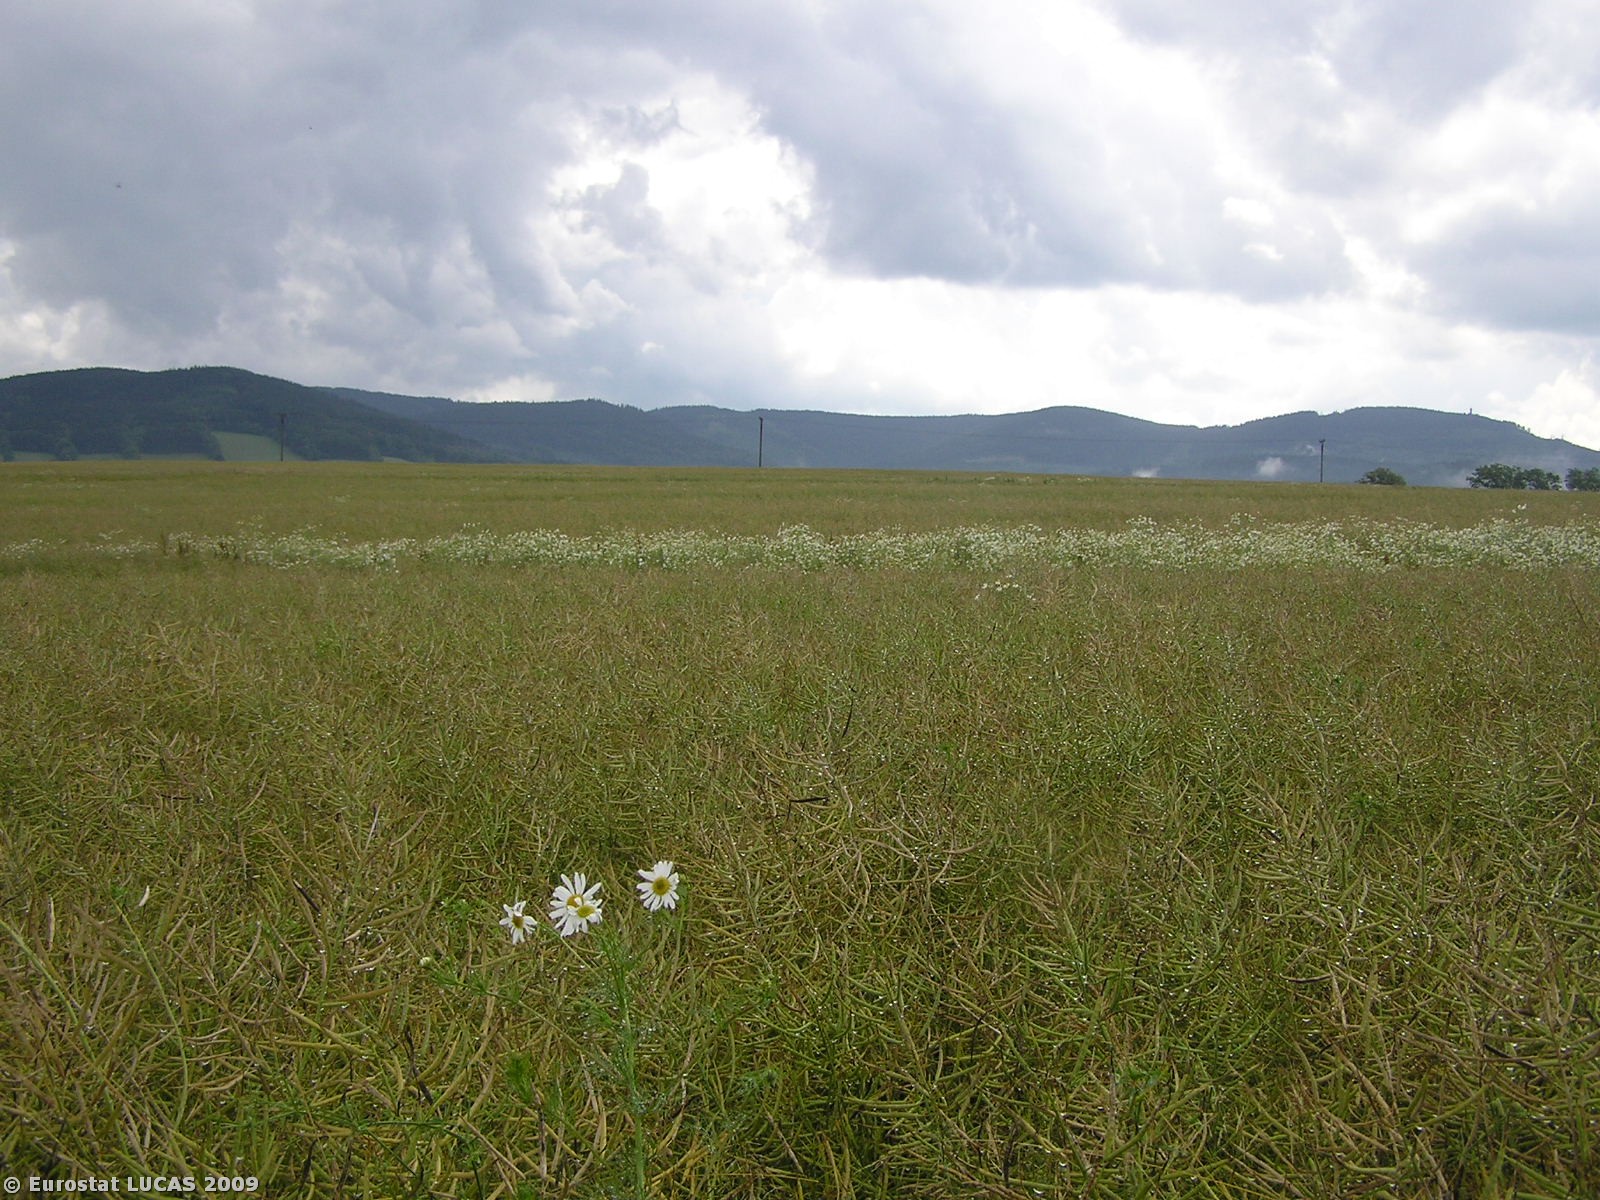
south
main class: Cropland
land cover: Rape and turnip rape
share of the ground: > 75 %
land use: Agriculture (excluding fallow land and kitchen gardens)
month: July
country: CZ
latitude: 50.2773
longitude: 17.2659
